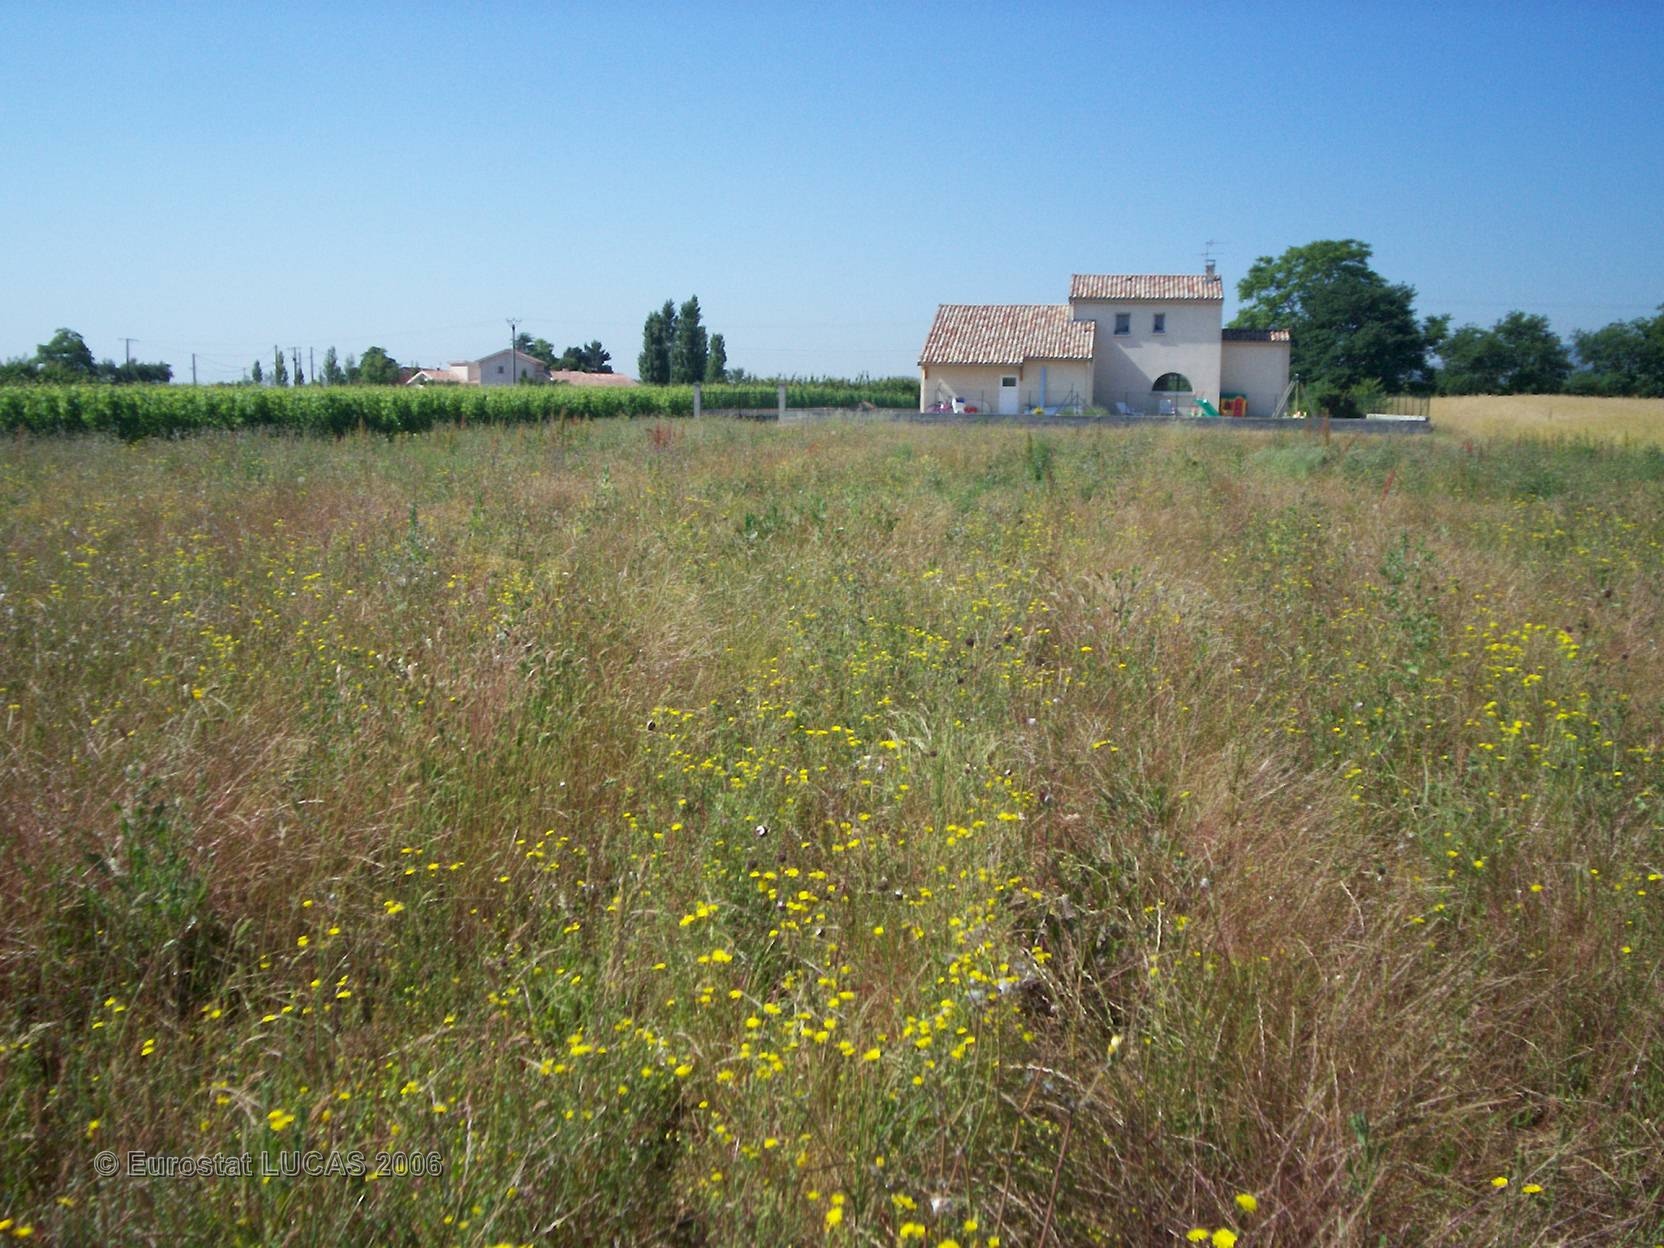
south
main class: Grassland
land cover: Grassland without tree/shrub cover
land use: Fallow land
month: June
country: FR
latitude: 45.0556
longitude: 4.8880
